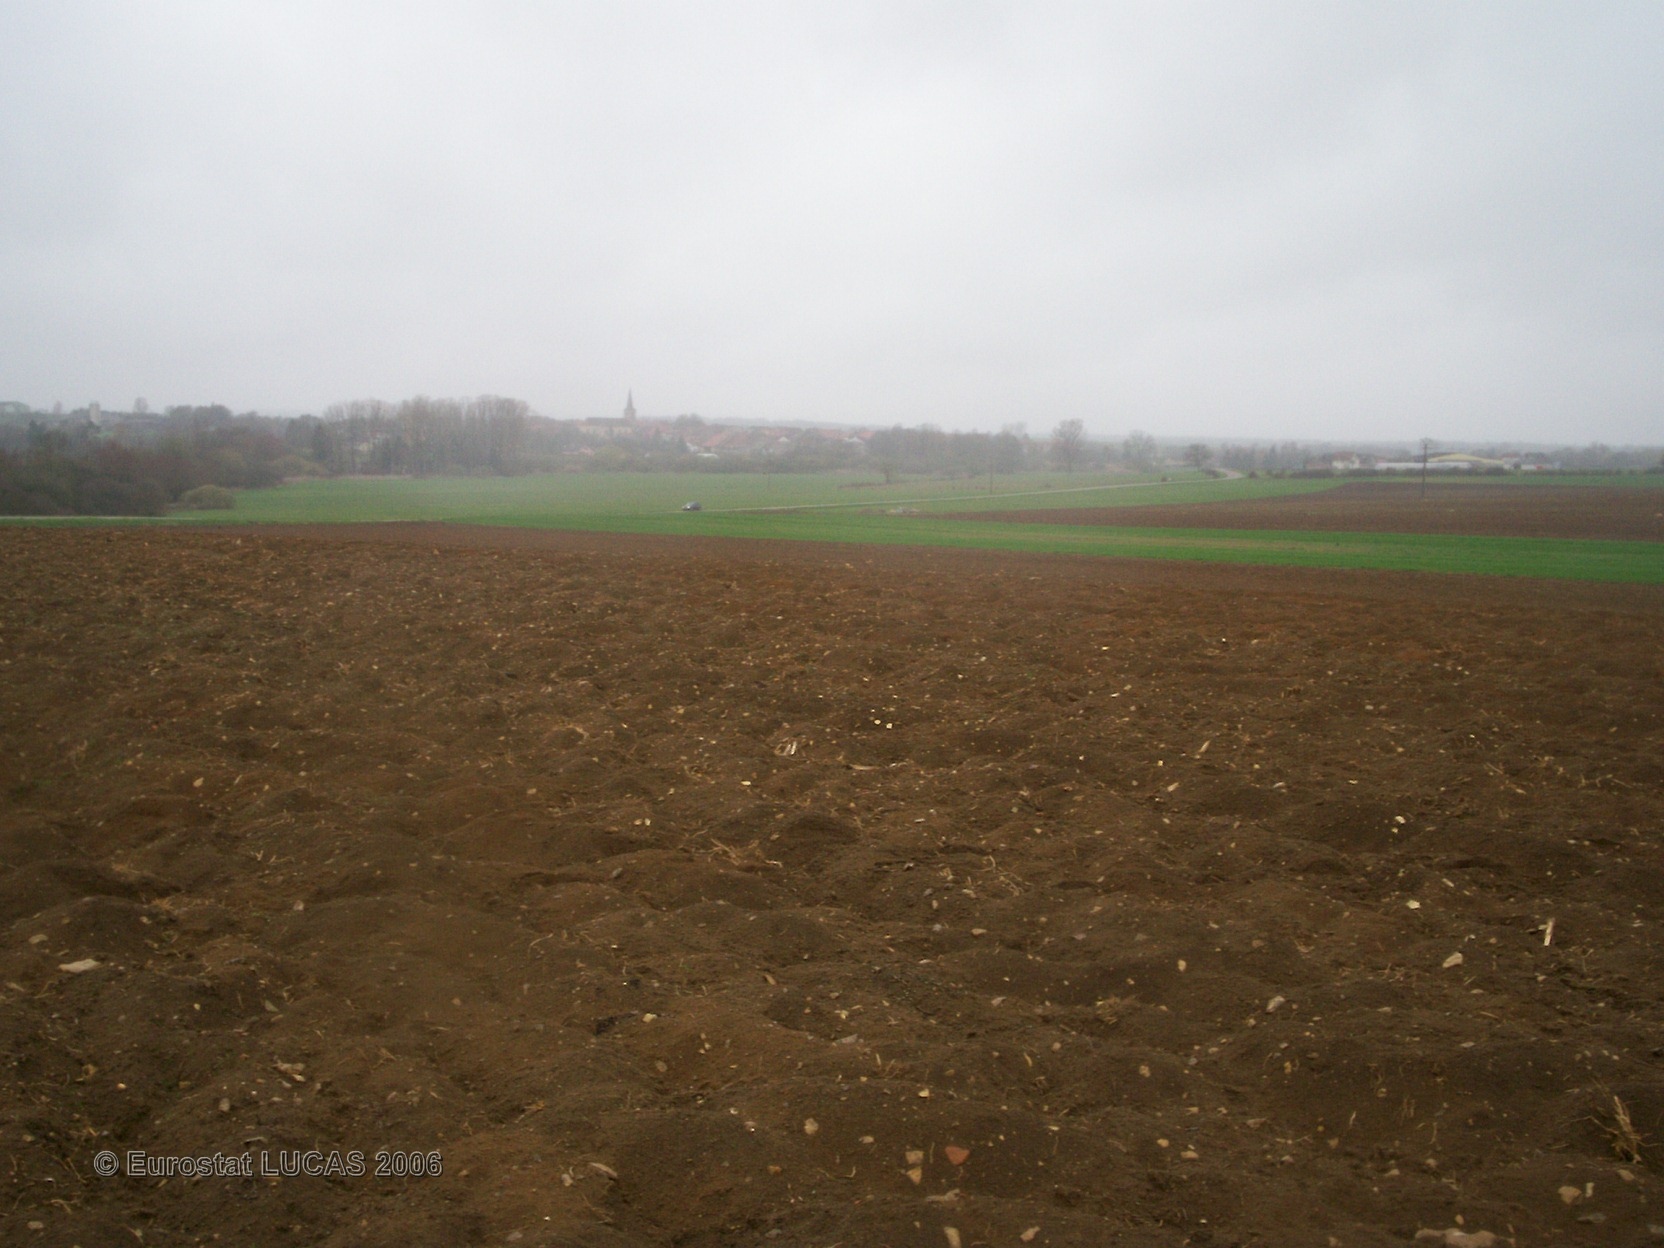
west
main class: Cropland
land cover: Maize
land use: Agriculture (excluding fallow land and kitchen gardens)
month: May
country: FR
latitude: 48.6854
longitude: 6.9443
